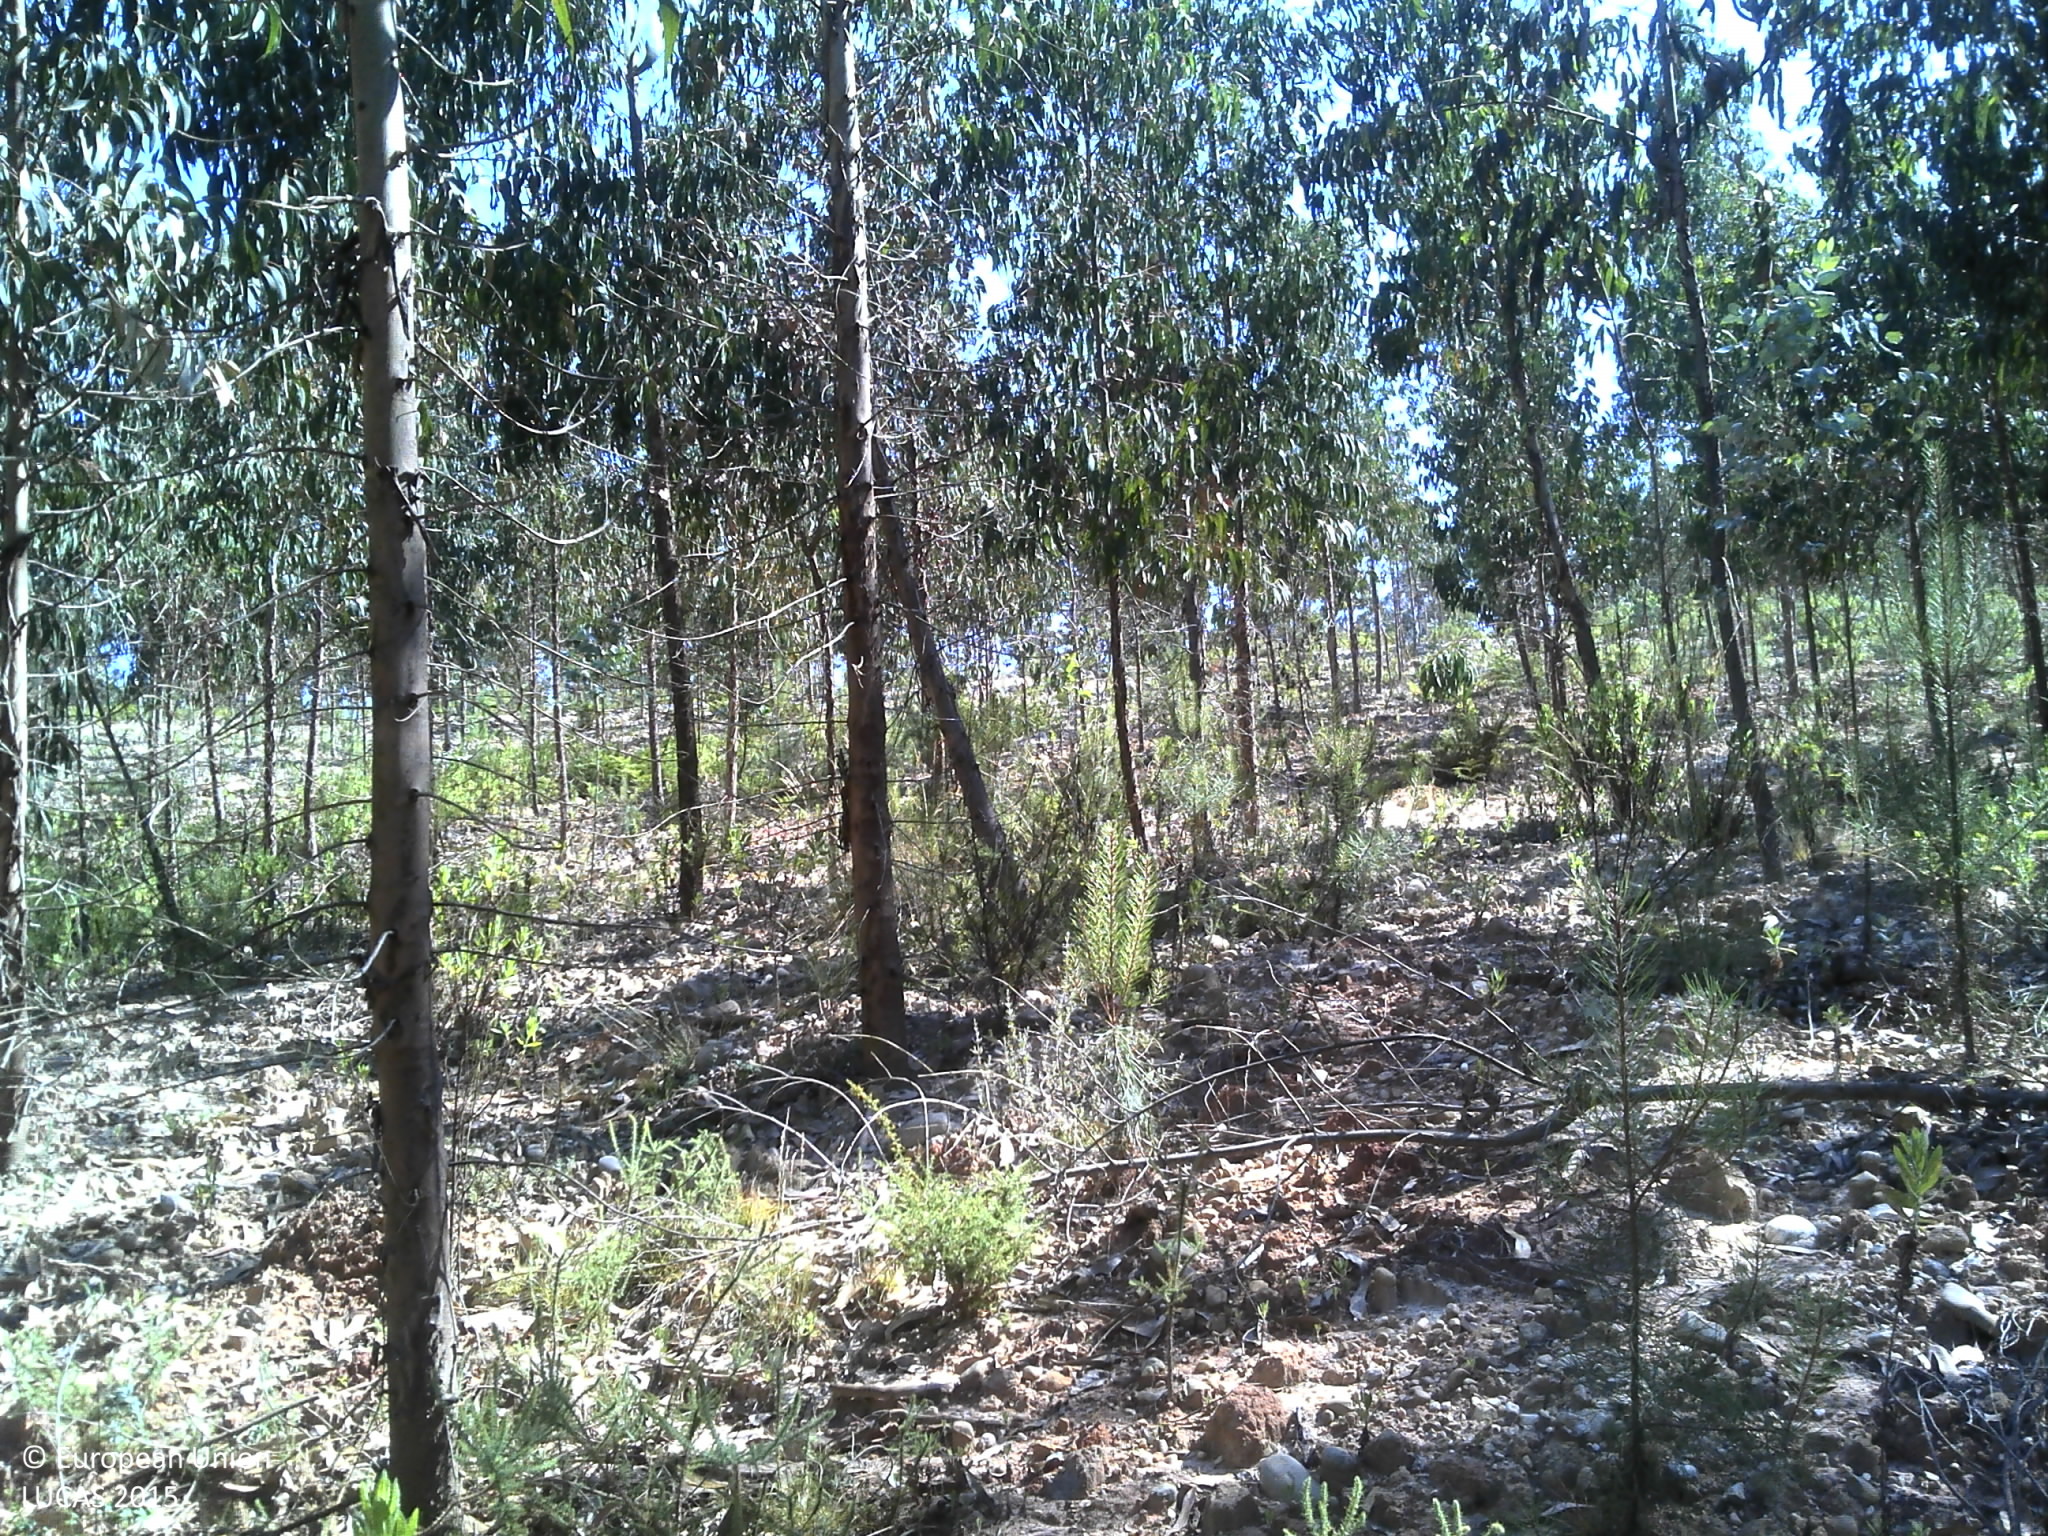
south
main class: Woodland
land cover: Broadleaved woodland
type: exotic forest
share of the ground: 50 - 75 %
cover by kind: broadleaved forest trees 60 %, unconsolidated bare surface 25 %, shrubs 15 %
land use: Forestry
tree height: > 5 m
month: June
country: PT
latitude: 39.6944
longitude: -8.8735
